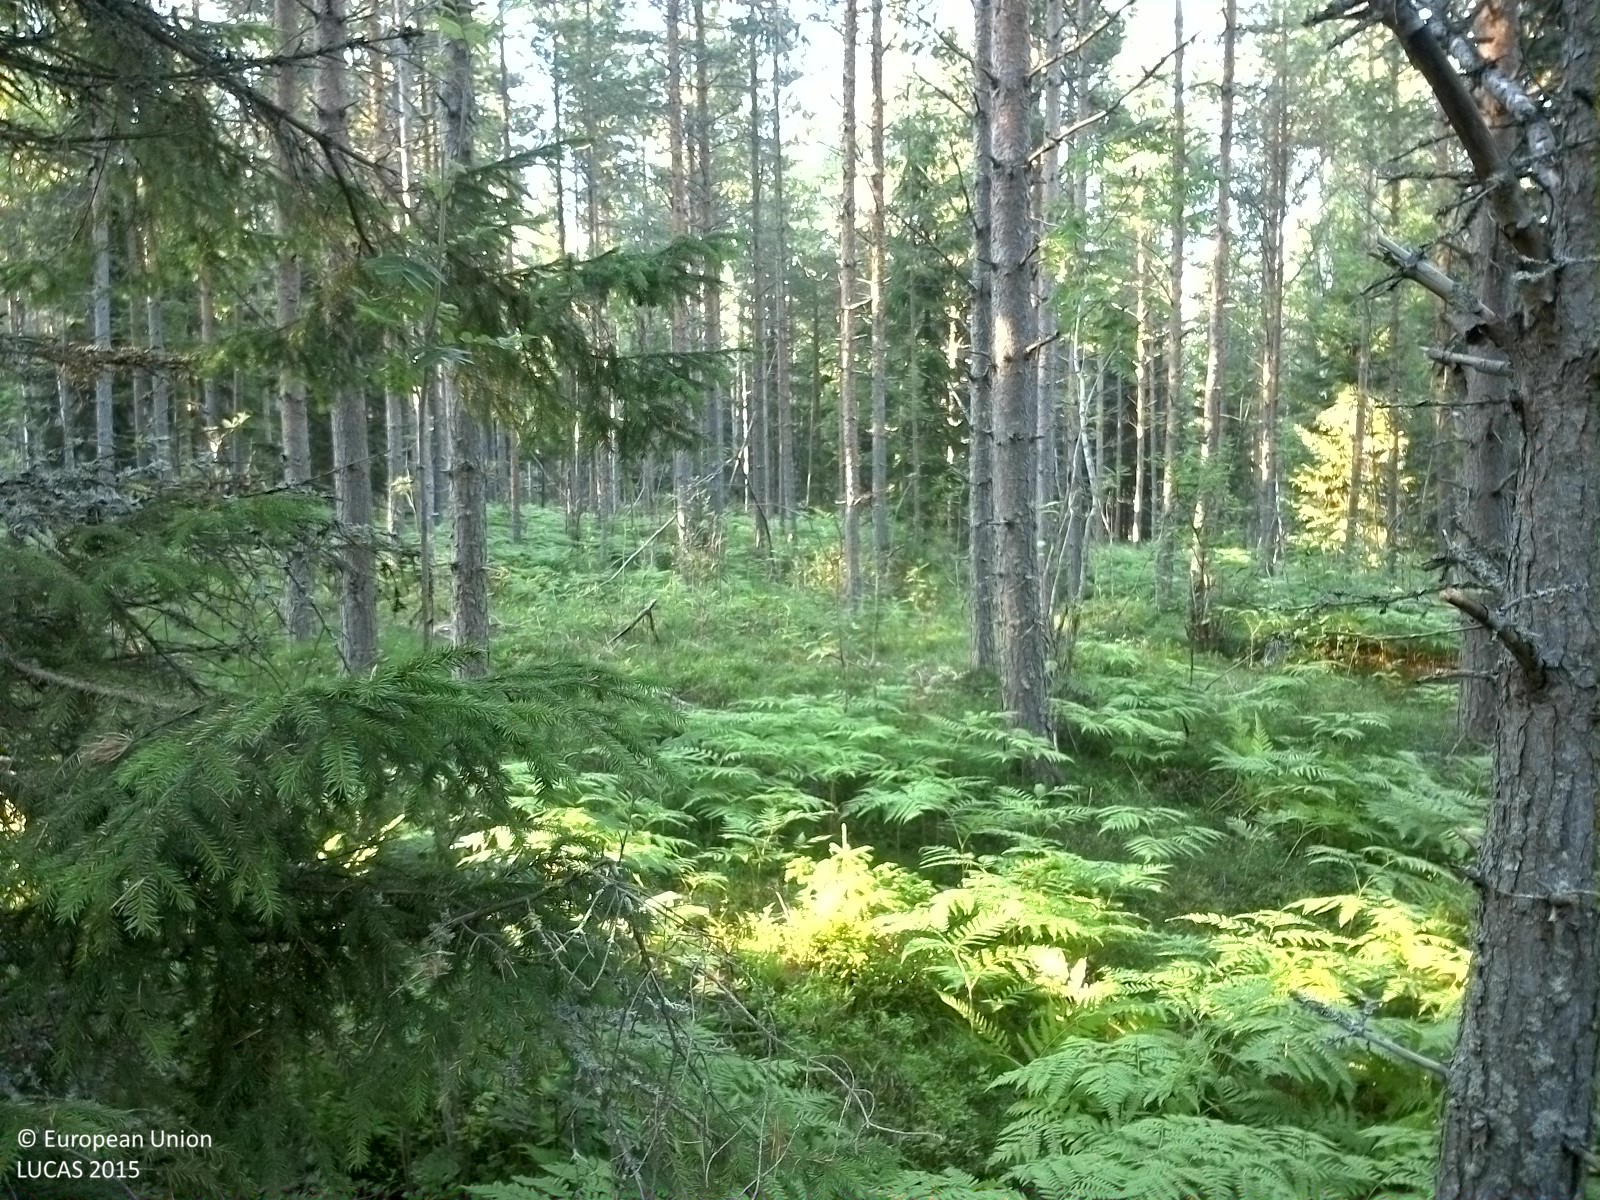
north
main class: Woodland
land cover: Pine dominated coniferous woodland
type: boreal forest
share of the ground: 50 - 75 %
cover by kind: coniferous forest trees 55 %, herbaceous plants 30 %, shrubs 15 %
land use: Forestry
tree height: > 5 m
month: August
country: SE
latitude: 62.5859
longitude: 17.9042
